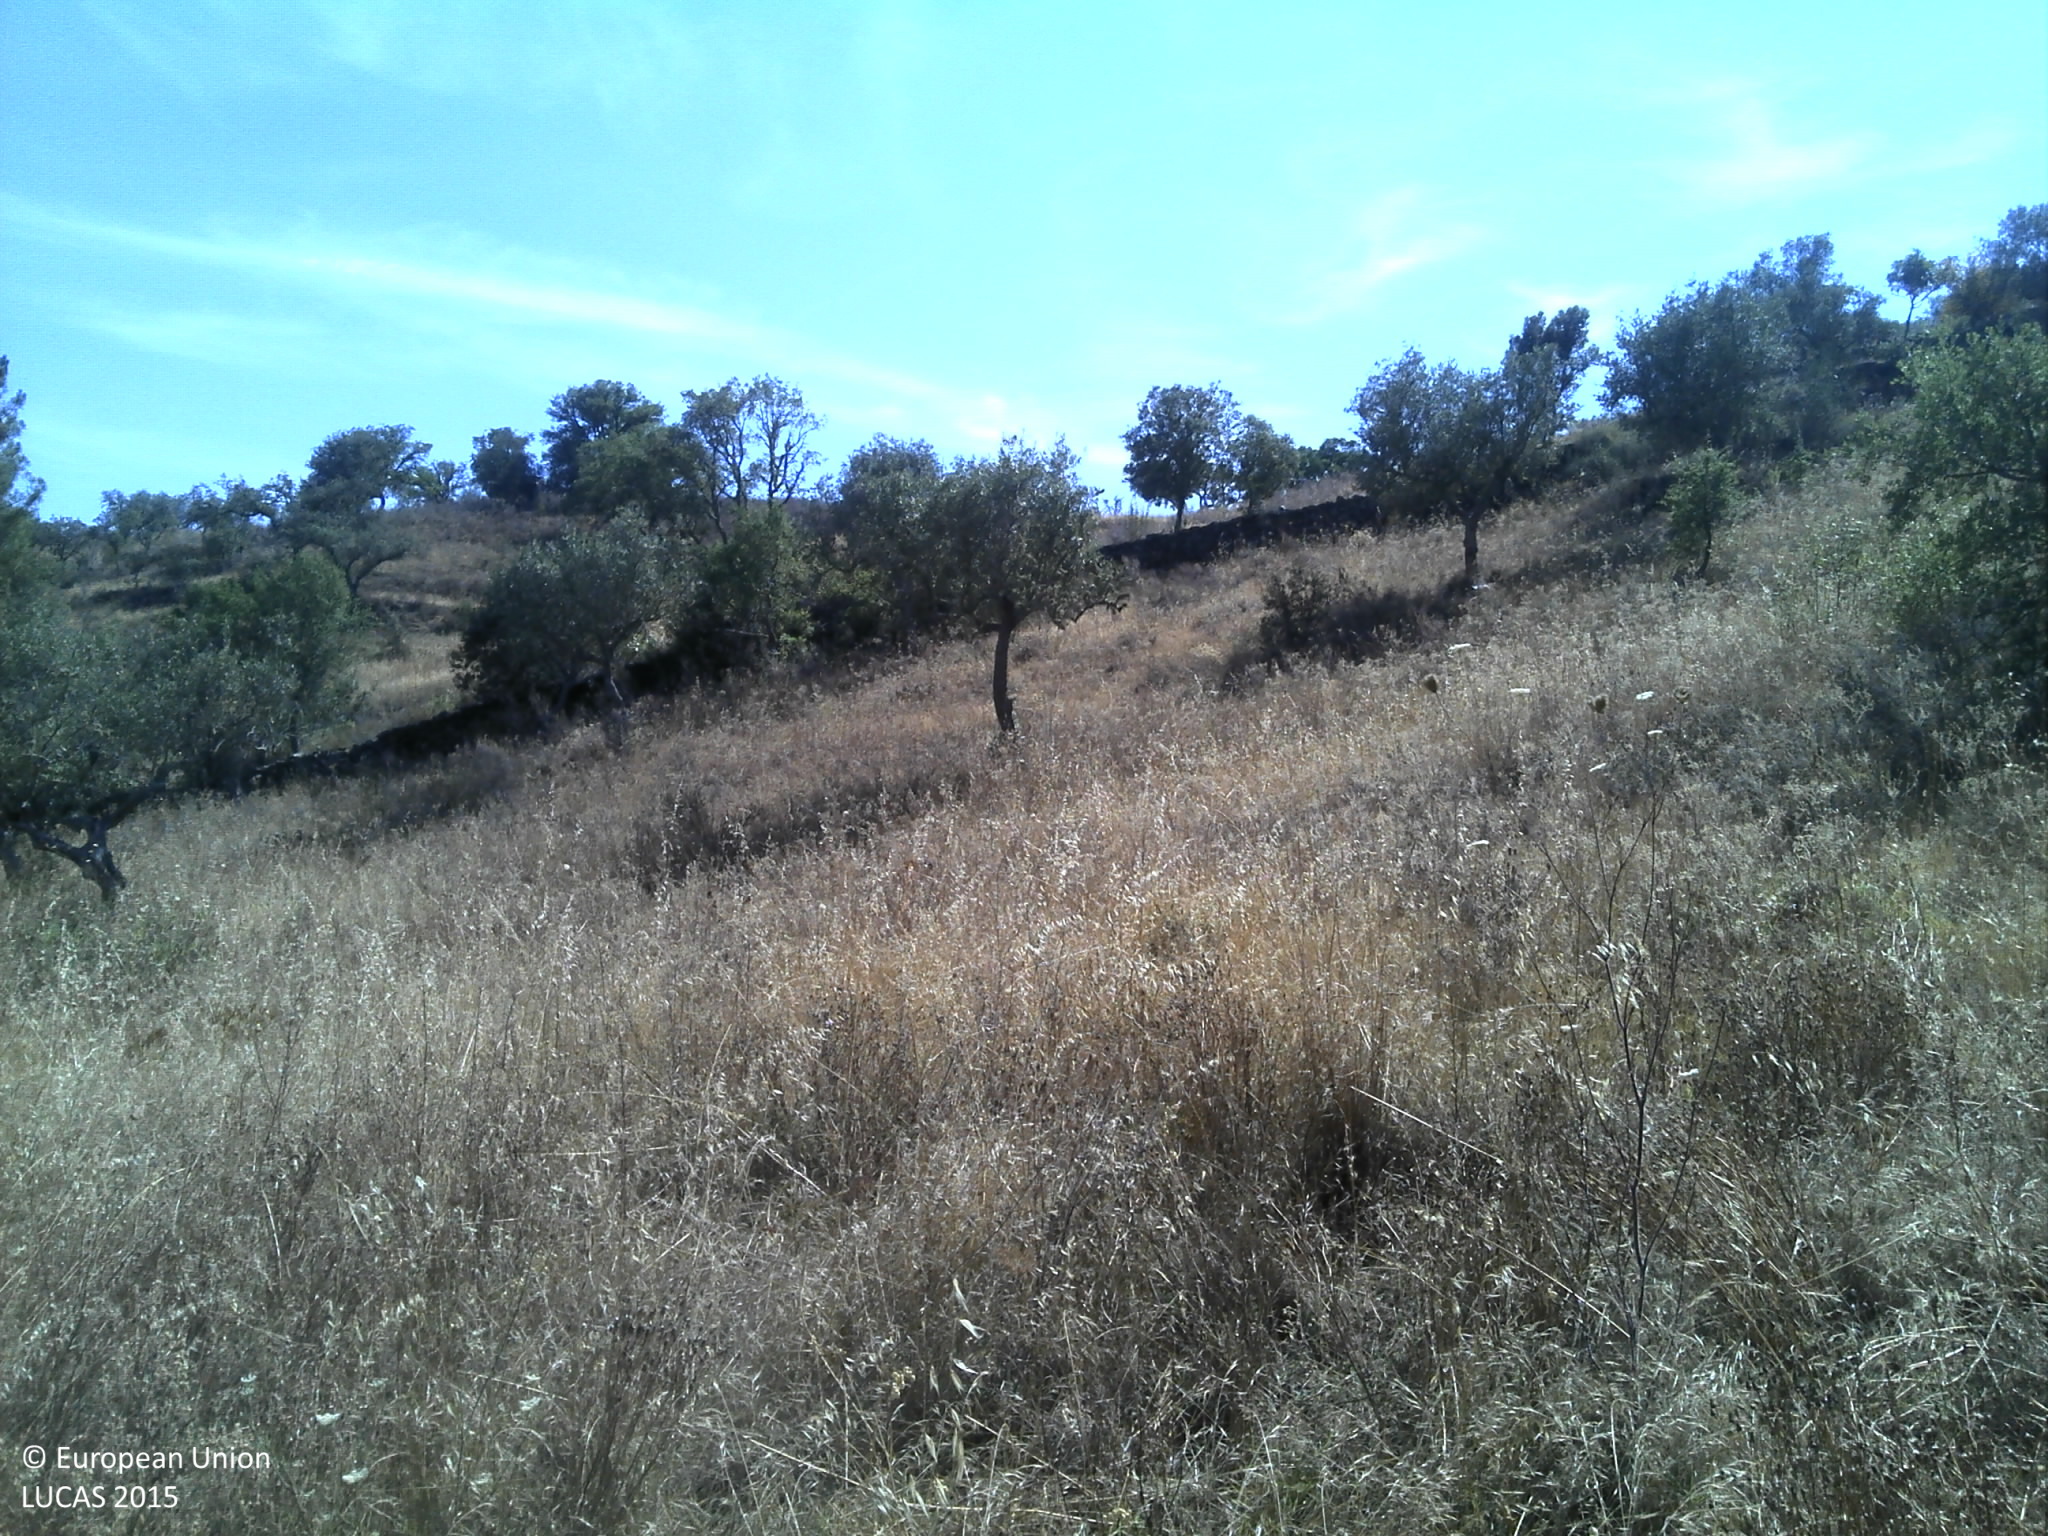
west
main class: Woodland
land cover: Broadleaved woodland
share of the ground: 25 - 50 %
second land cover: Spontaneously vegetated surfaces
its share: 25 - 50 %
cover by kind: herbaceous plants 40 %, broadleaved forest trees 35 %, unconsolidated bare surface 20 %, shrubs 5 %
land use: Forestry
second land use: Agriculture (excluding fallow land and kitchen gardens)
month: July
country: PT
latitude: 39.6645
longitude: -7.5711
